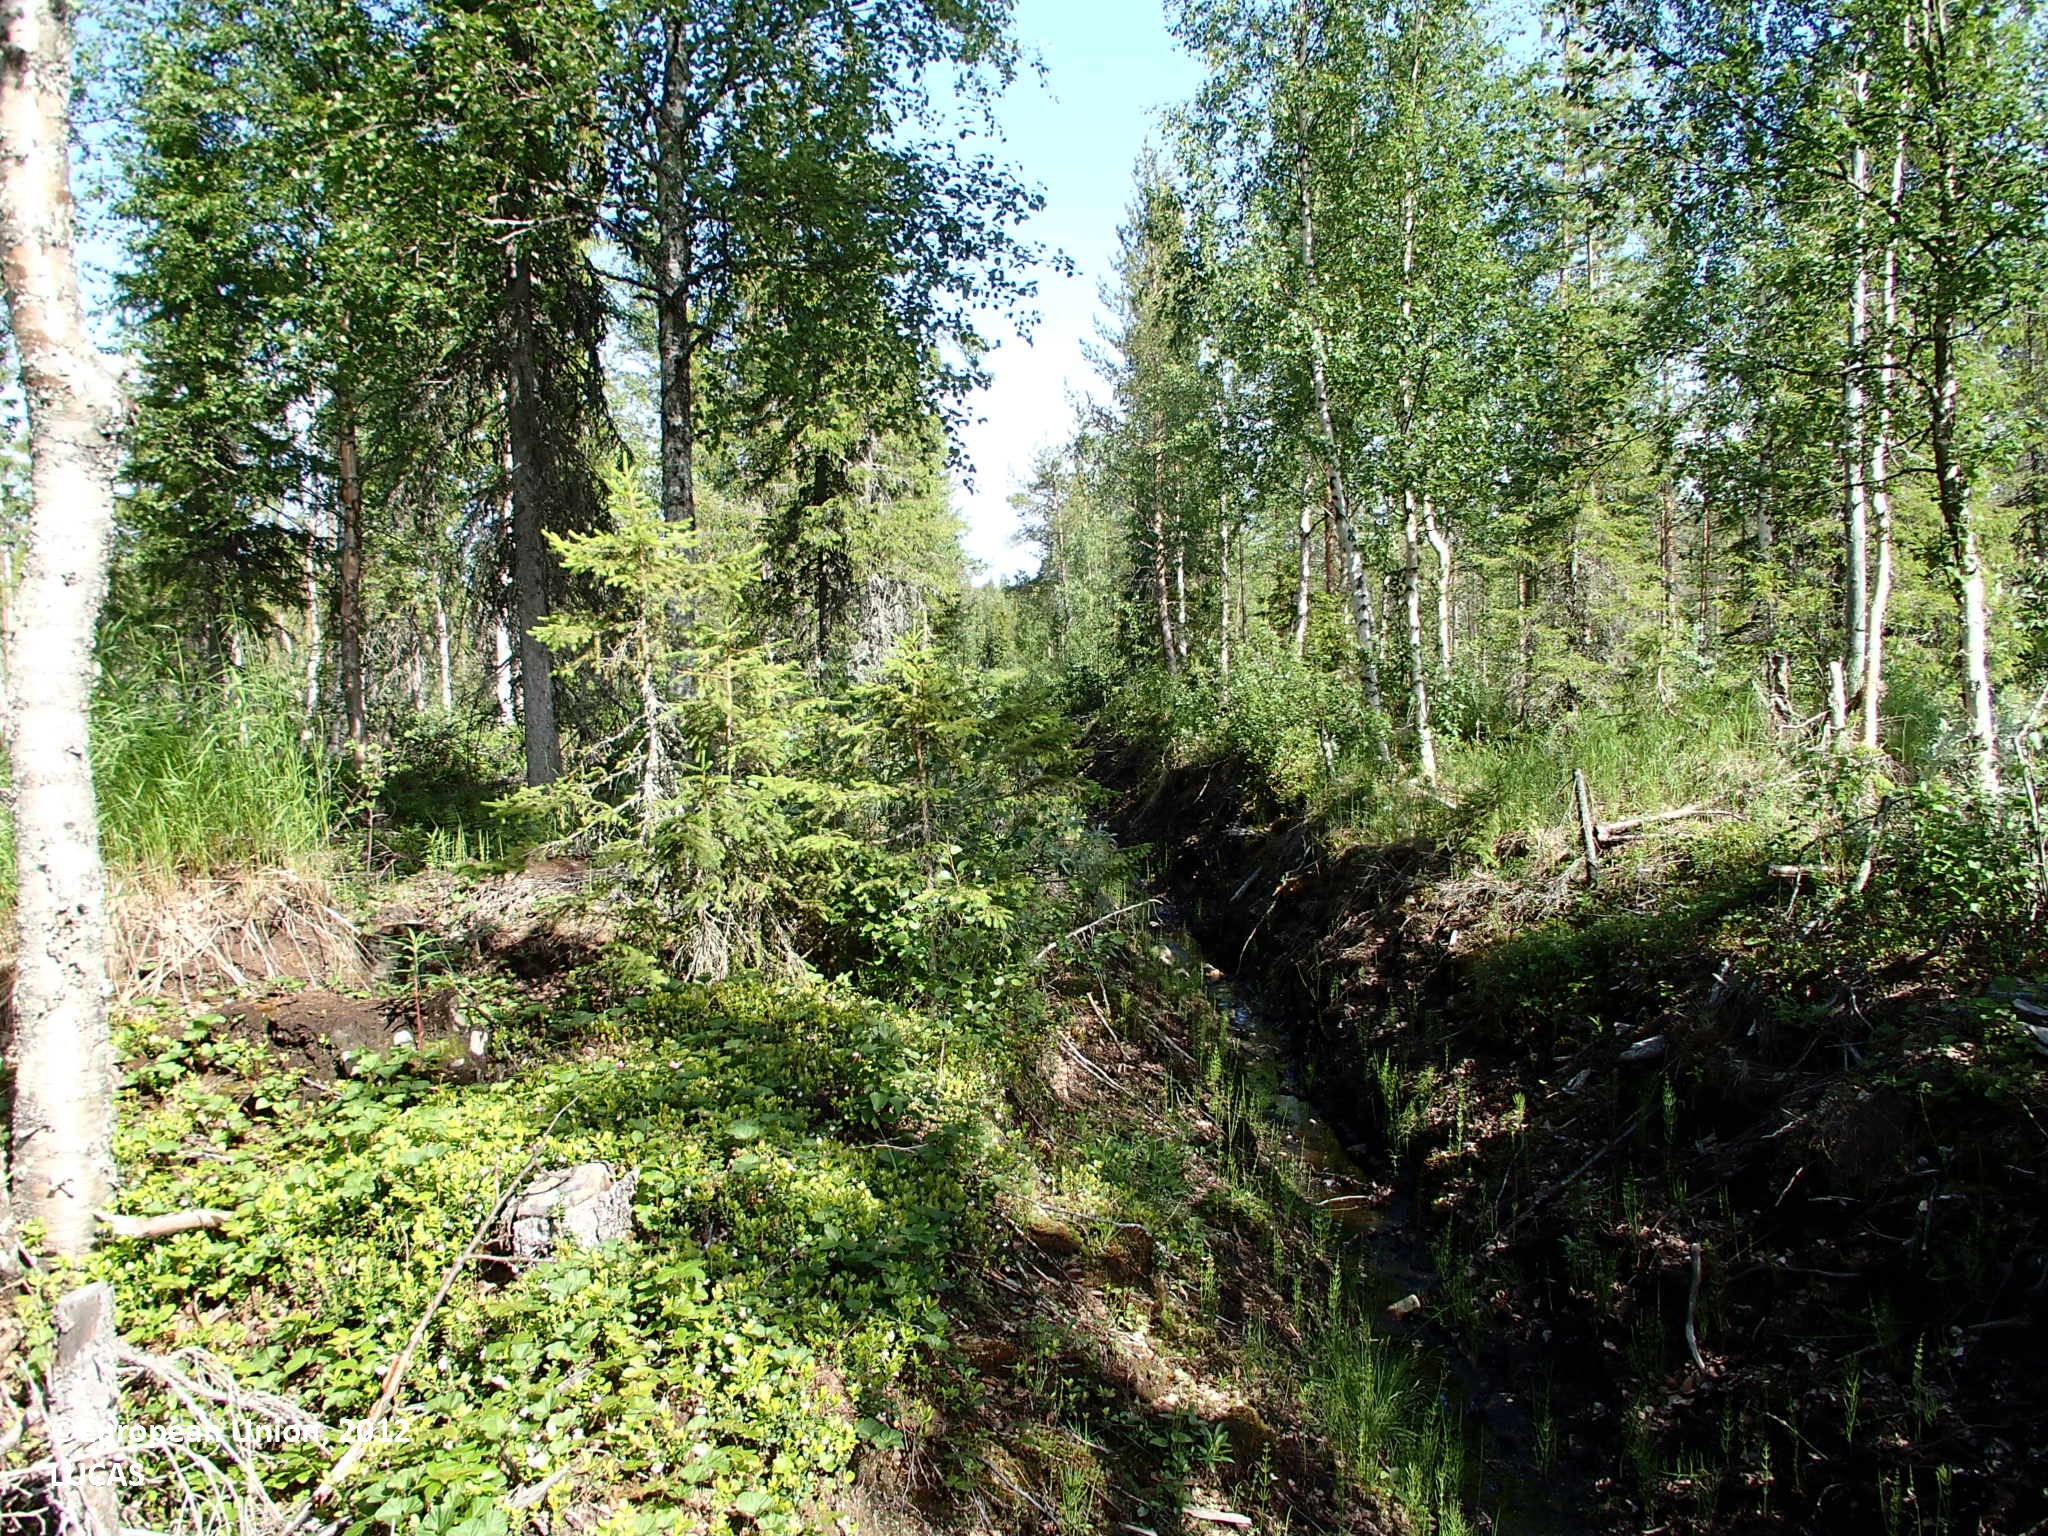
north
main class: Woodland
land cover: Broadleaved woodland
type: boreal forest
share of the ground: 50 - 75 %
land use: Forestry
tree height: > 5 m
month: July
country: FI
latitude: 67.3847
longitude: 26.1680
